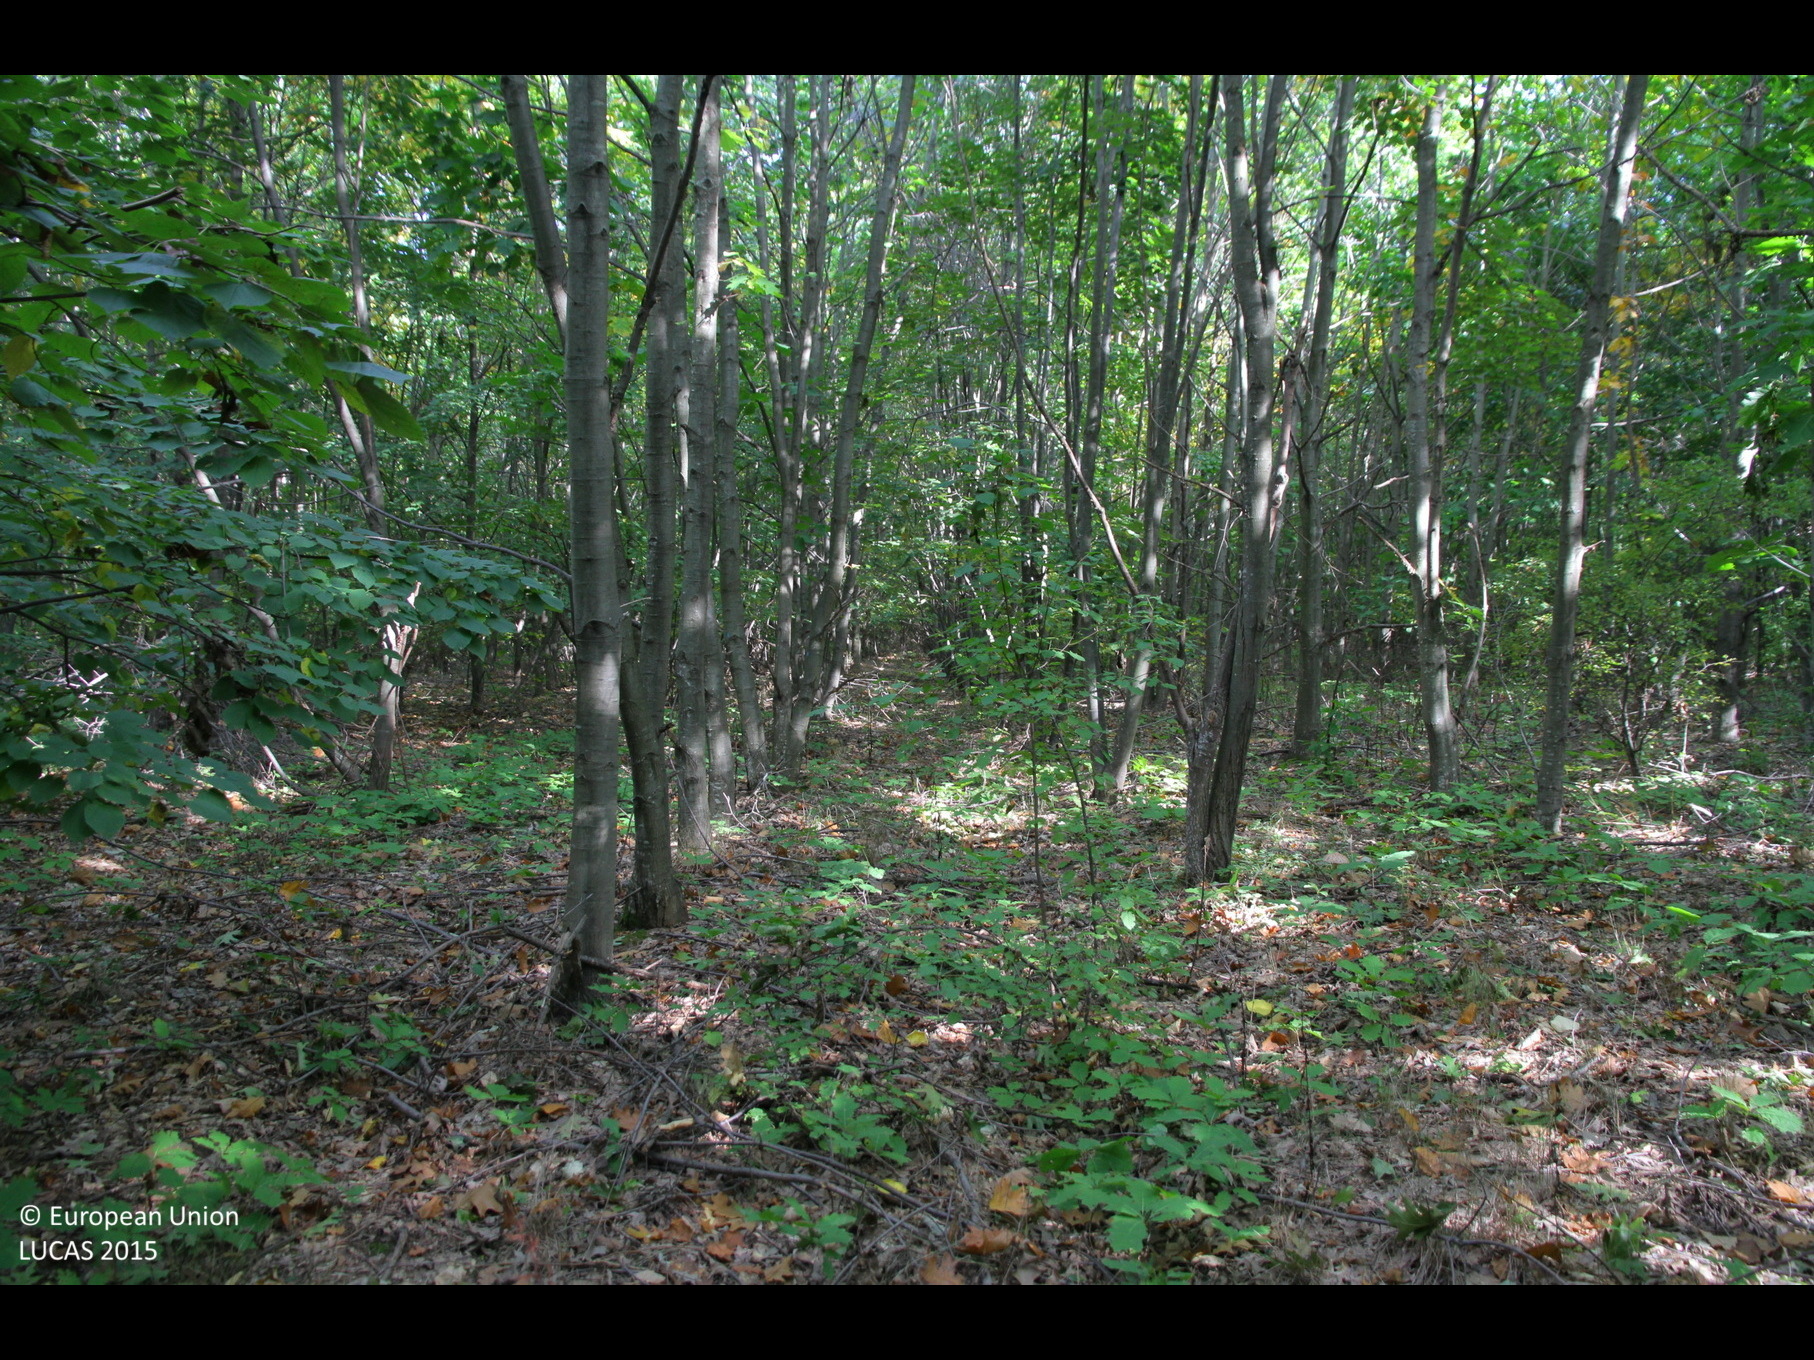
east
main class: Woodland
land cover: Broadleaved woodland
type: acidophilous oak and oak-birch forest
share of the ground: > 75 %
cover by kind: broadleaved forest trees 100 %
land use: Forestry
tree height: > 5 m
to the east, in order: Broadleaved woodland
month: October
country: BG
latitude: 43.4863
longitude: 27.2236
